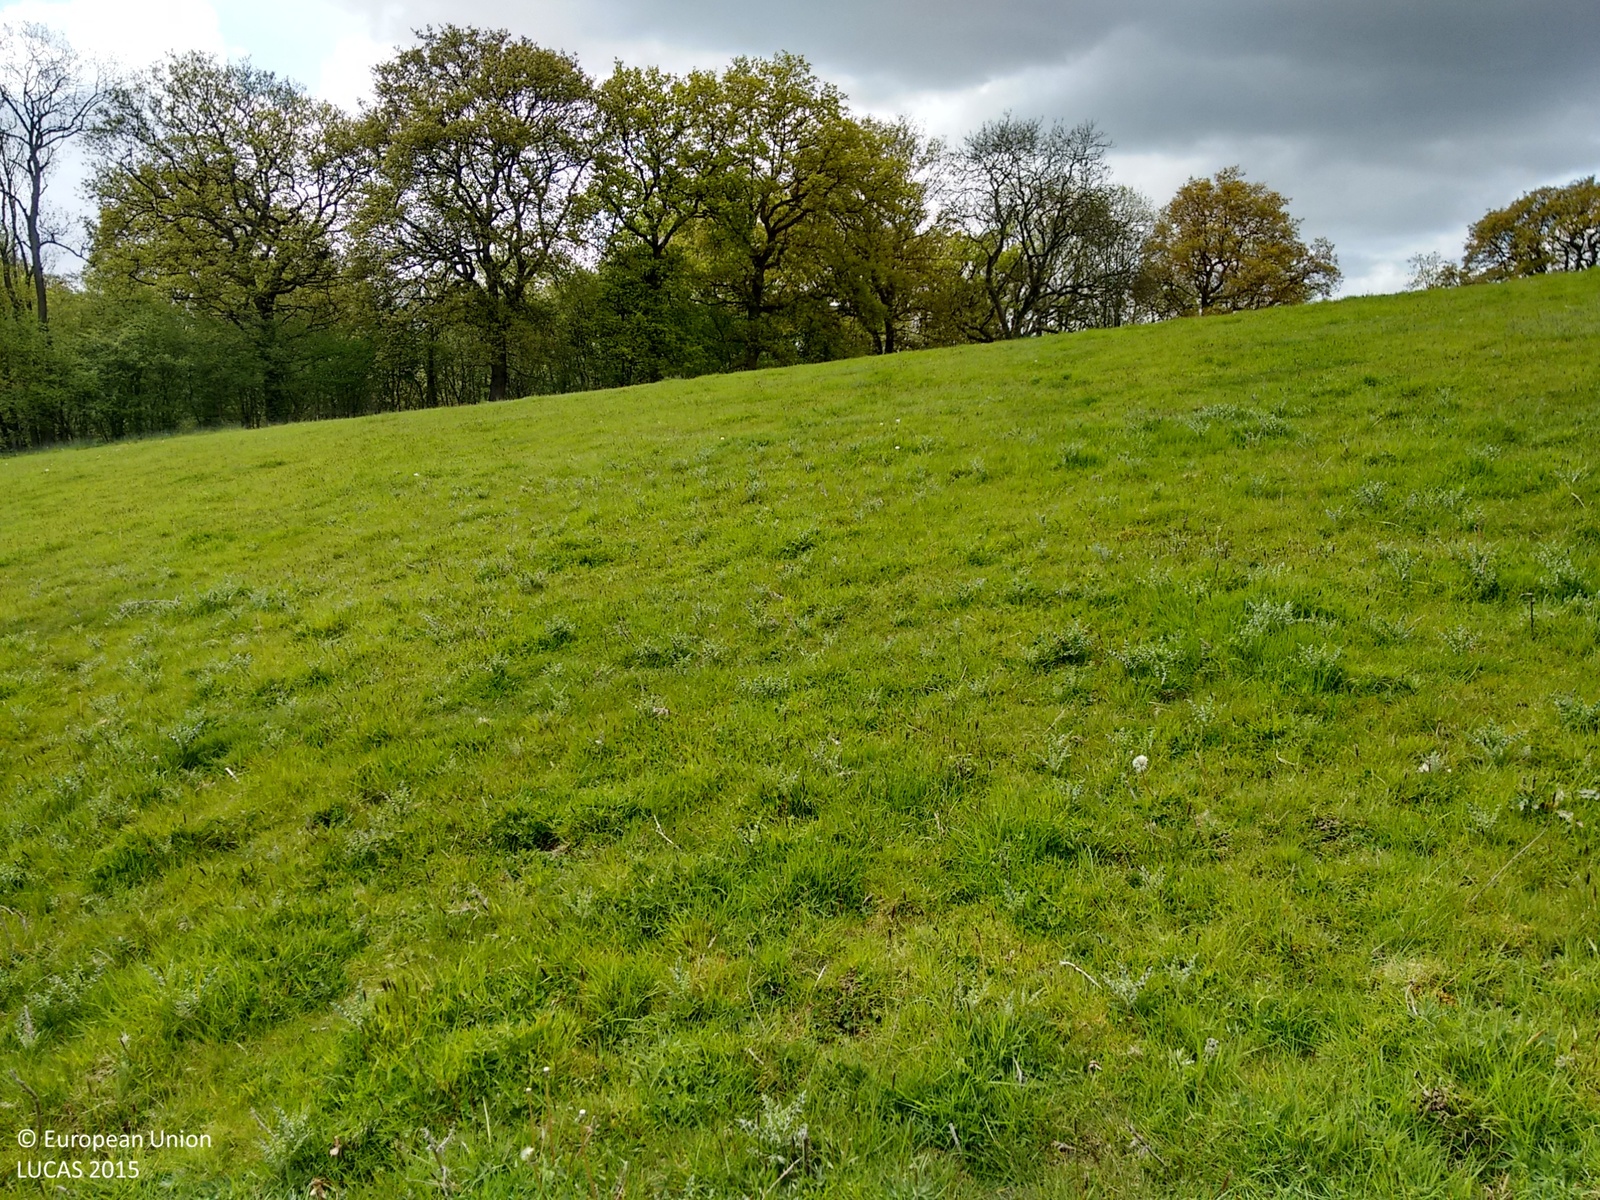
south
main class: Grassland
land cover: Grassland without tree/shrub cover
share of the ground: > 75 %
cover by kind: herbaceous plants 100 %
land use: Agriculture (excluding fallow land and kitchen gardens)
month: May
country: GB
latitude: 51.2428
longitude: 0.1563
